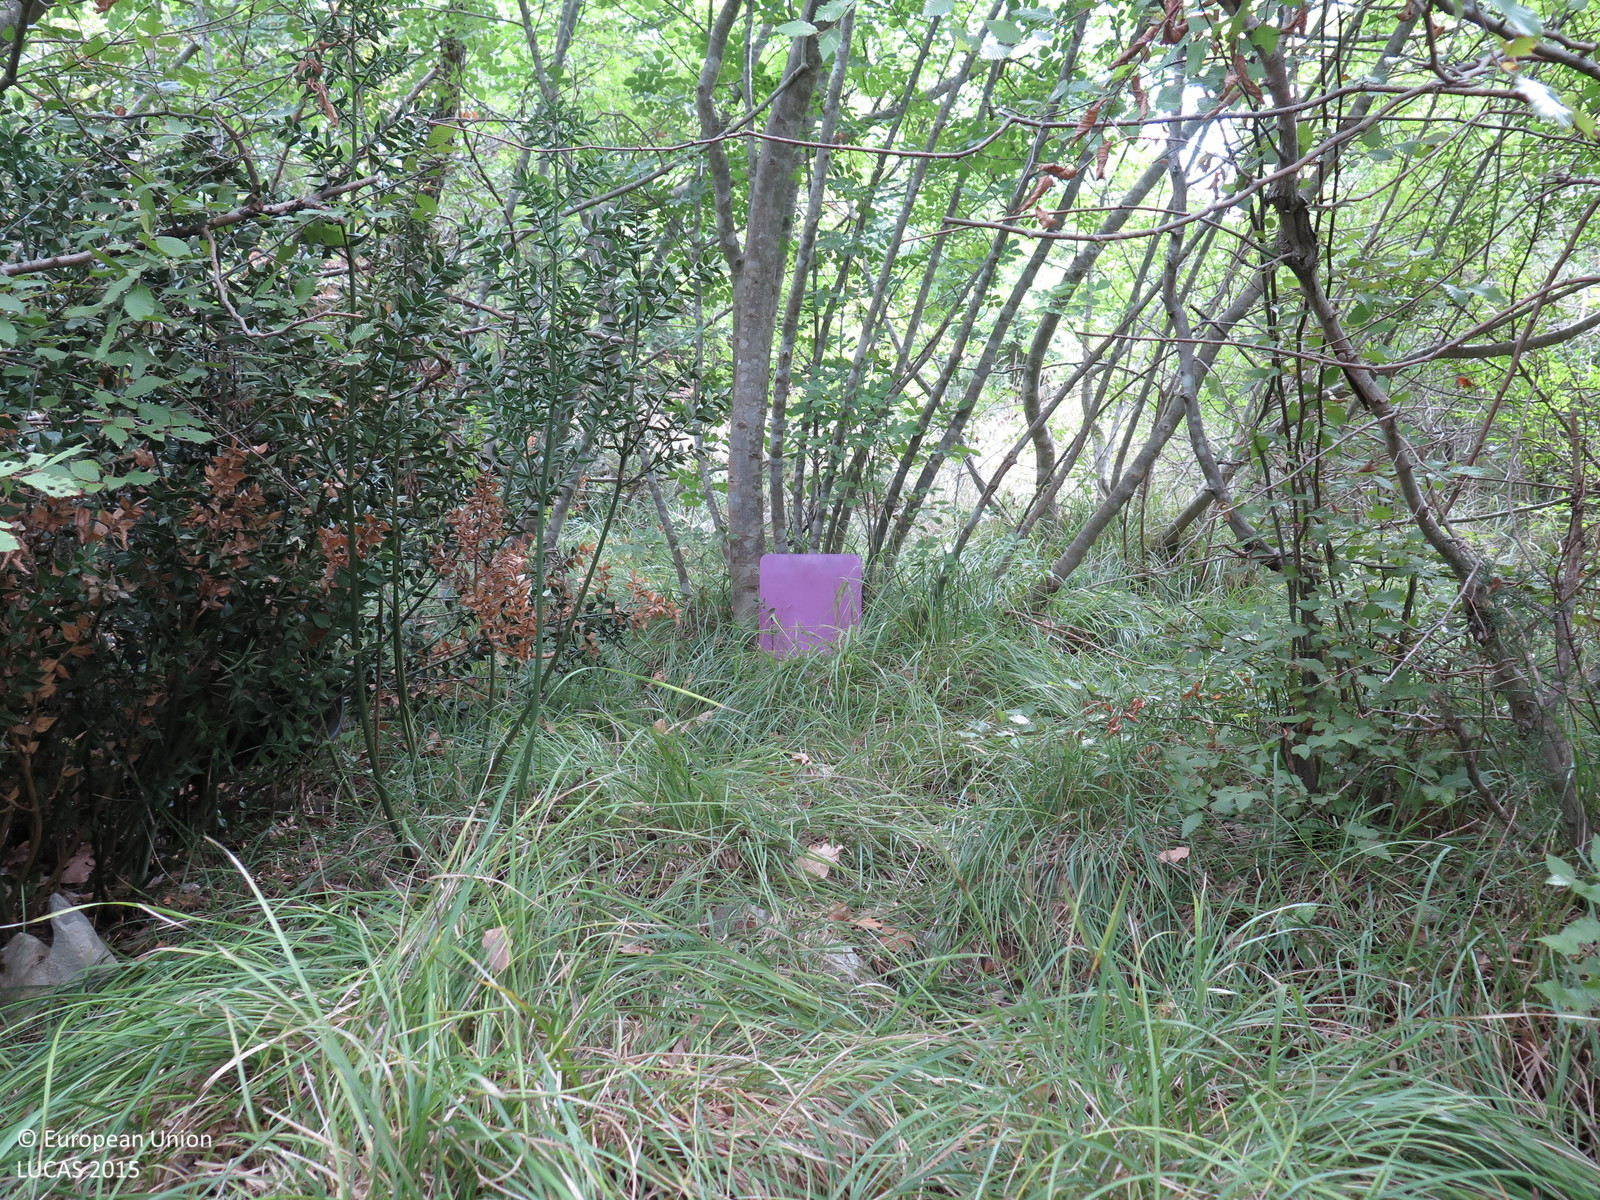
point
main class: Woodland
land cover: Broadleaved woodland
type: thermophilous deciduous forest
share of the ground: > 75 %
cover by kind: broadleaved forest trees 90 %, shrubs 5 %, herbaceous plants 5 %
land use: Semi-natural and natural areas not in use
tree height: > 5 m
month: August
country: HR
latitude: 45.1543
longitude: 14.5356
